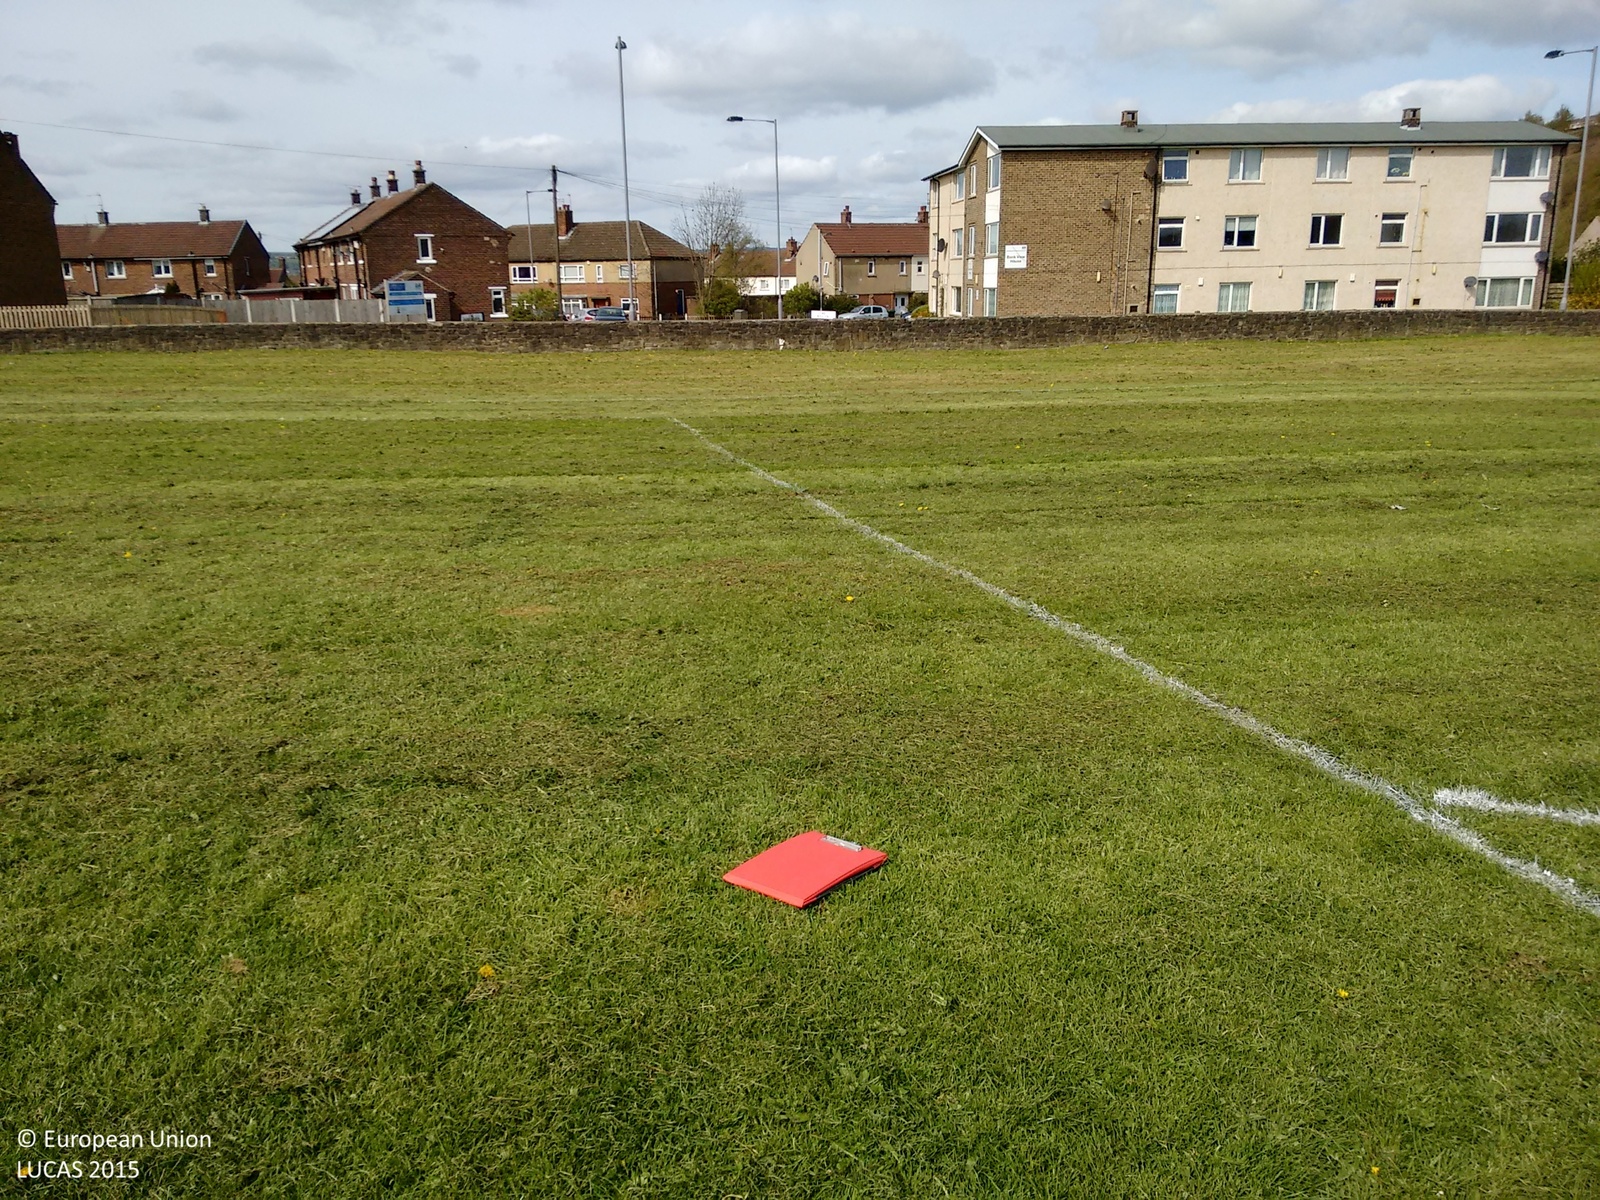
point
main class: Grassland
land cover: Grassland without tree/shrub cover
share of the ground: > 75 %
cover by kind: herbaceous plants 100 %
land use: Sport
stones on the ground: < 10 %
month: May
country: GB
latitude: 53.8434
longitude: -1.7717
